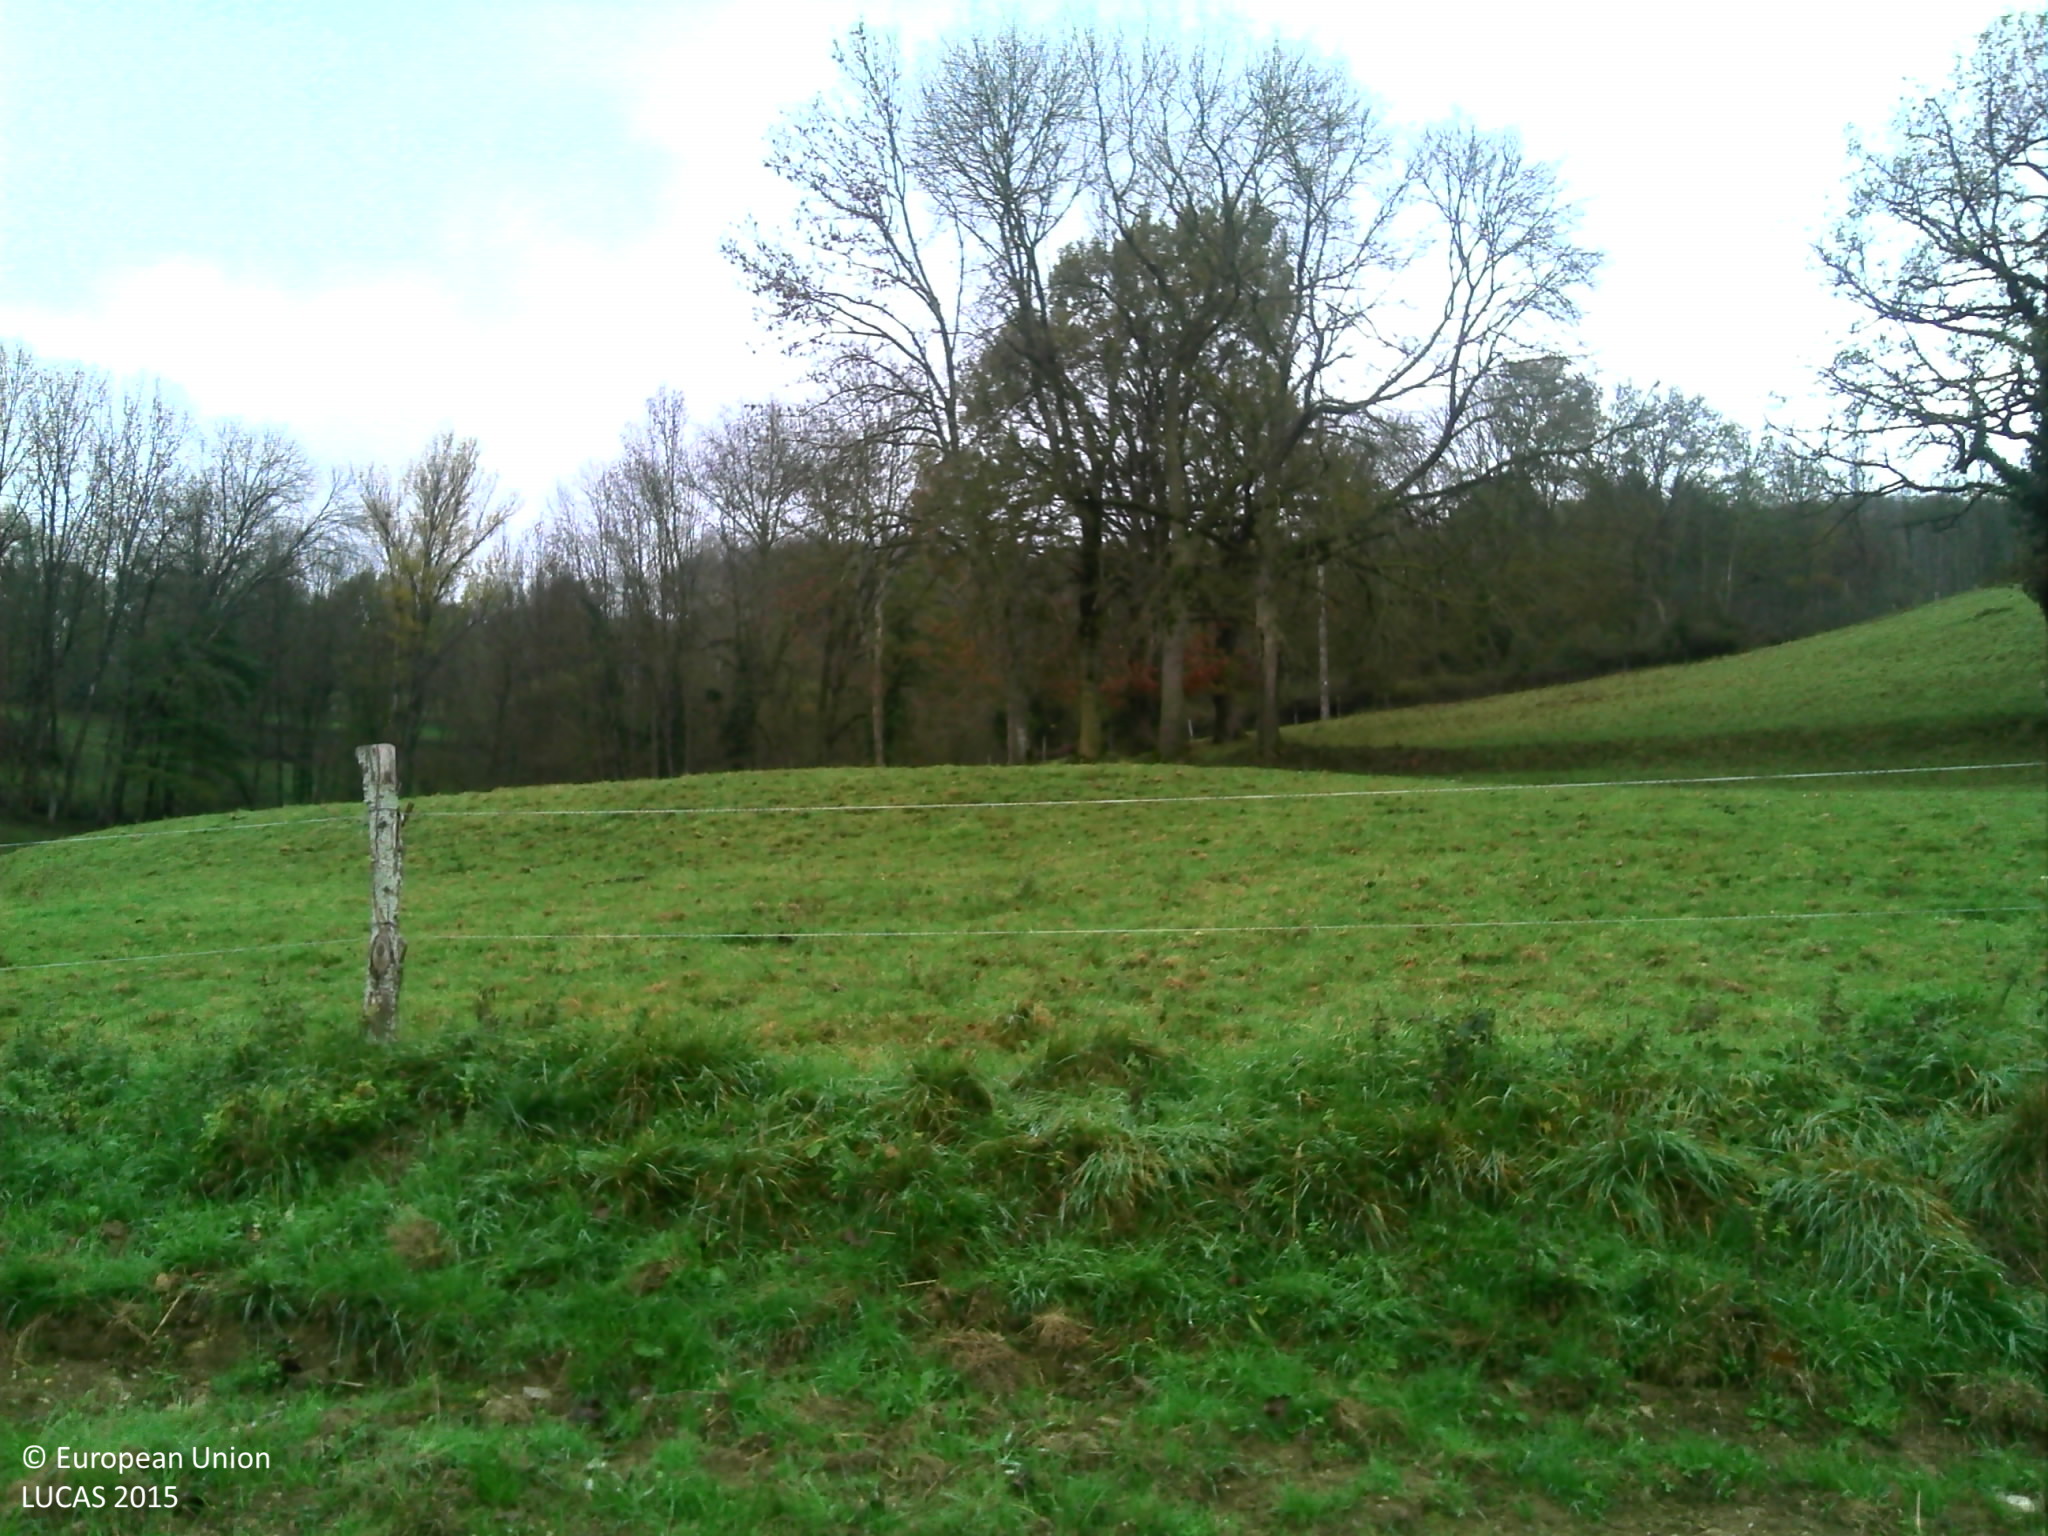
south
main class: Cropland
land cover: Temporary grasslands
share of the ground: > 75 %
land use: Agriculture (excluding fallow land and kitchen gardens)
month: November
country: FR
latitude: 43.9192
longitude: 2.5453
